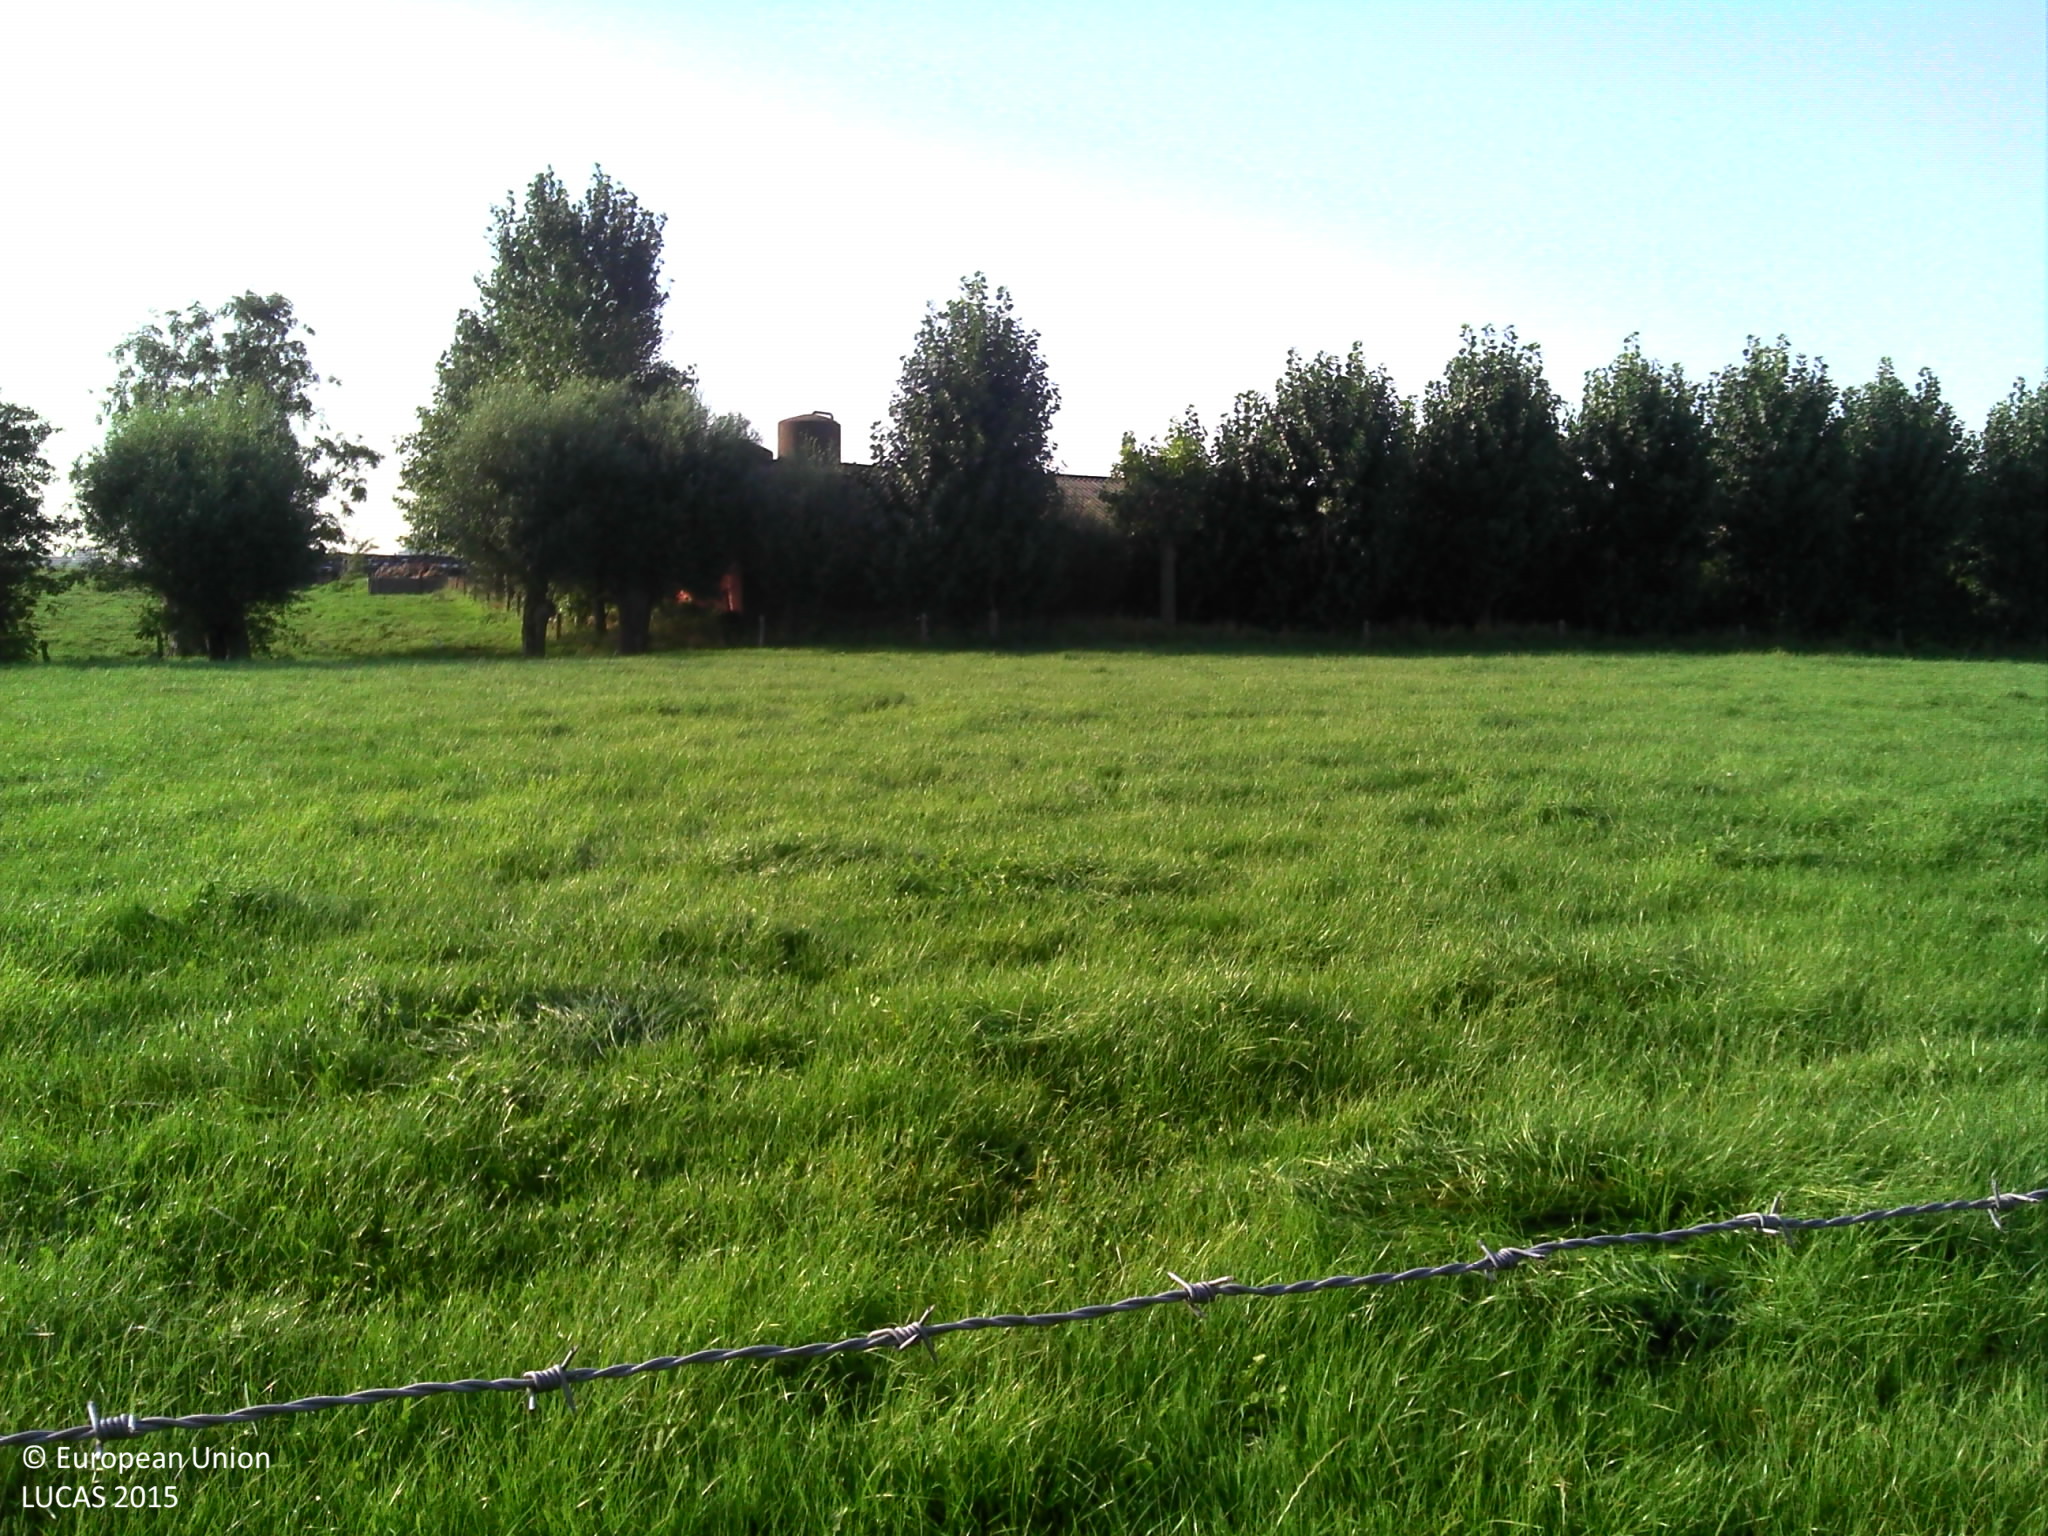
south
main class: Cropland
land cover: Maize
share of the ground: > 75 %
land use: Agriculture (excluding fallow land and kitchen gardens)
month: September
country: BE
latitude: 50.9977
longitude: 2.7071
